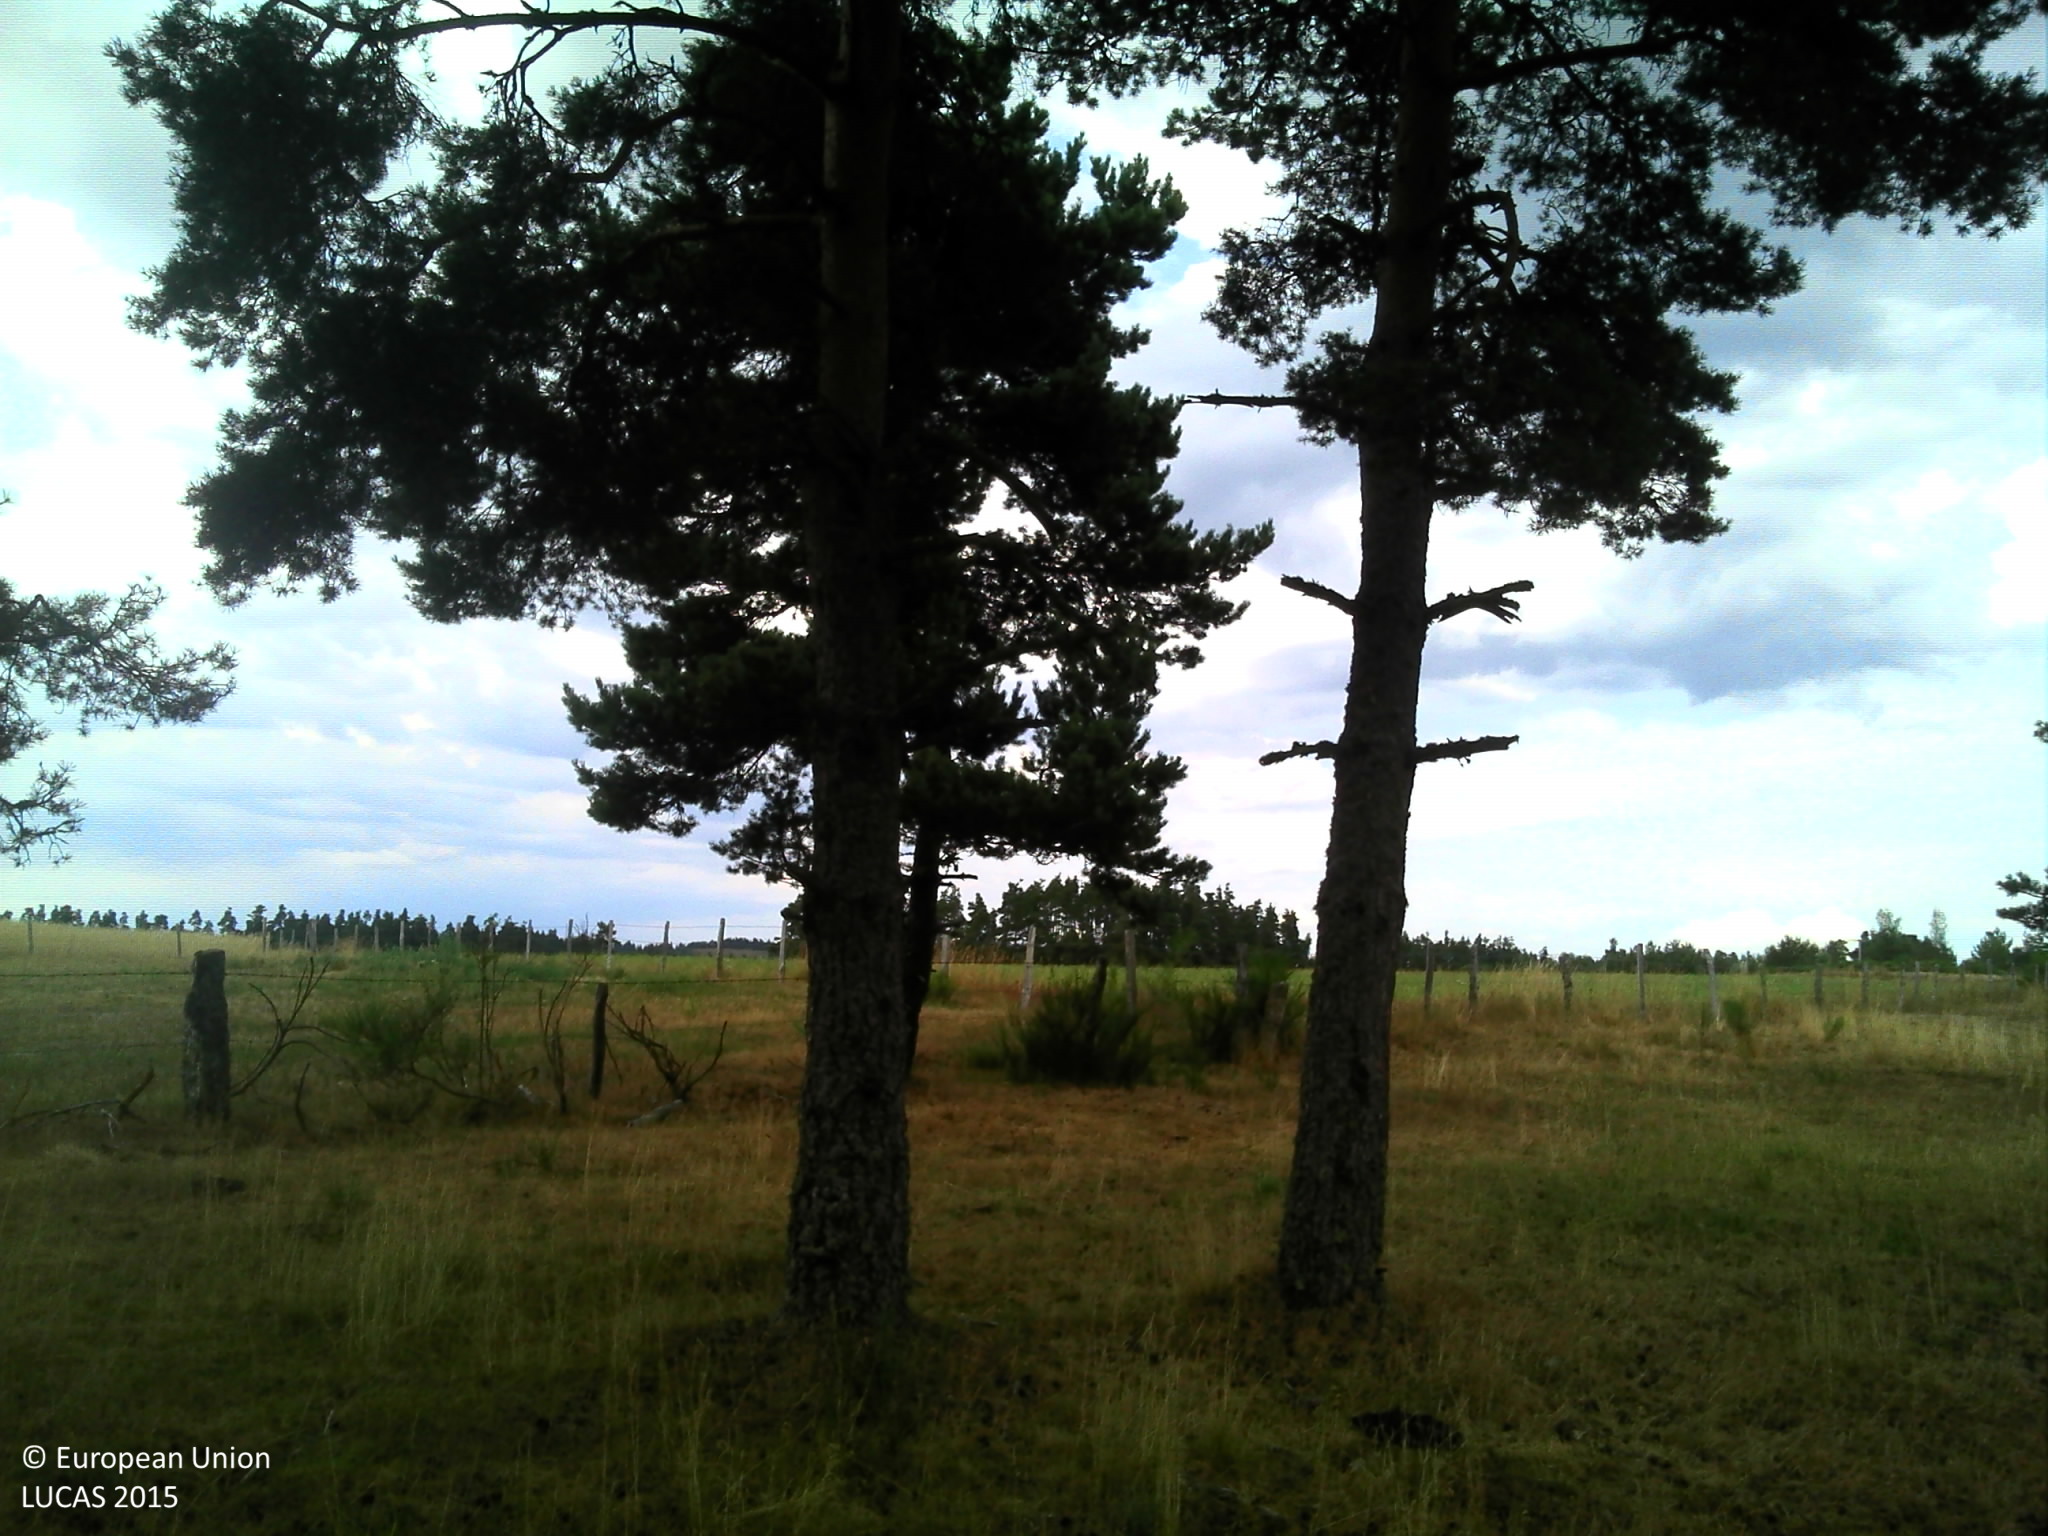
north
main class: Woodland
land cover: Pine dominated coniferous woodland
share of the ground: > 75 %
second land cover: Grassland without tree/shrub cover
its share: > 75 %
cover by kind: coniferous forest trees 95 %, broadleaved forest trees 5 %
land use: Forestry
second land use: Agriculture (excluding fallow land and kitchen gardens)
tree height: > 5 m
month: July
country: FR
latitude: 44.6933
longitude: 3.2782
